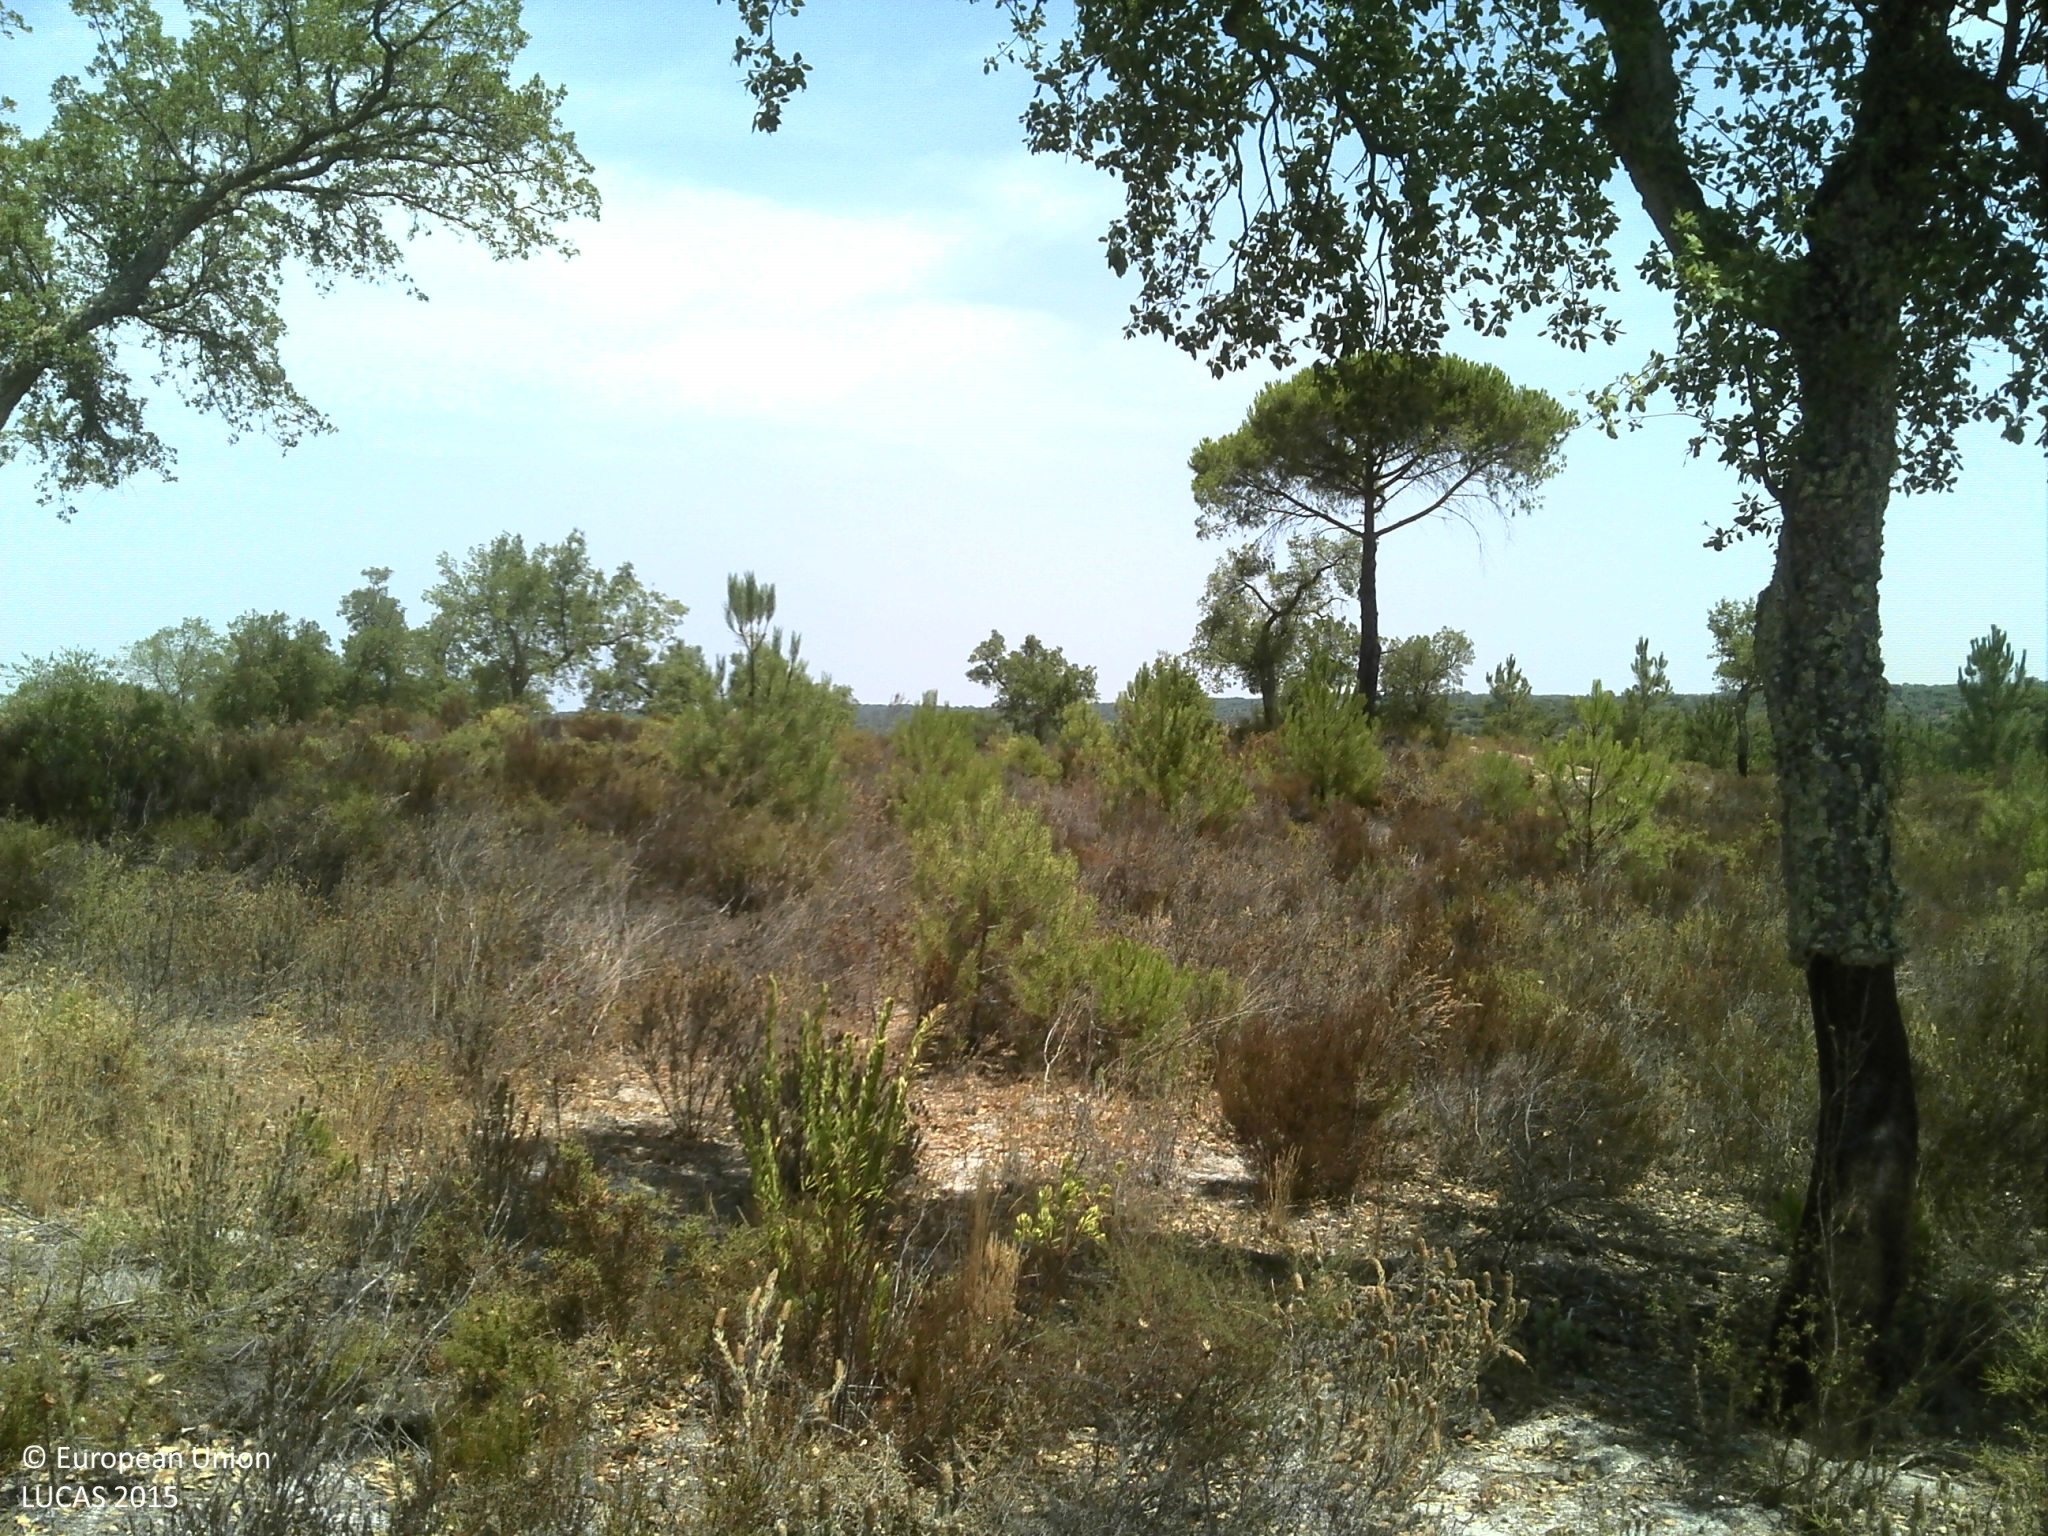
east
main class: Woodland
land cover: Pine dominated coniferous woodland
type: coniferous forest of the mediterranean region
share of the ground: 25 - 50 %
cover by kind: coniferous forest trees 45 %, unconsolidated bare surface 40 %, shrubs 15 %
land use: Forestry
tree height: > 5 m
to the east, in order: Pine dominated coniferous woodland; Tracks; Broadleaved woodland; Pine dominated coniferous woodland; Broadleaved woodland; Grassland without tree/shrub cover; Pine dominated coniferous woodland
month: July
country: PT
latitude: 39.1299
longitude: -8.2552
